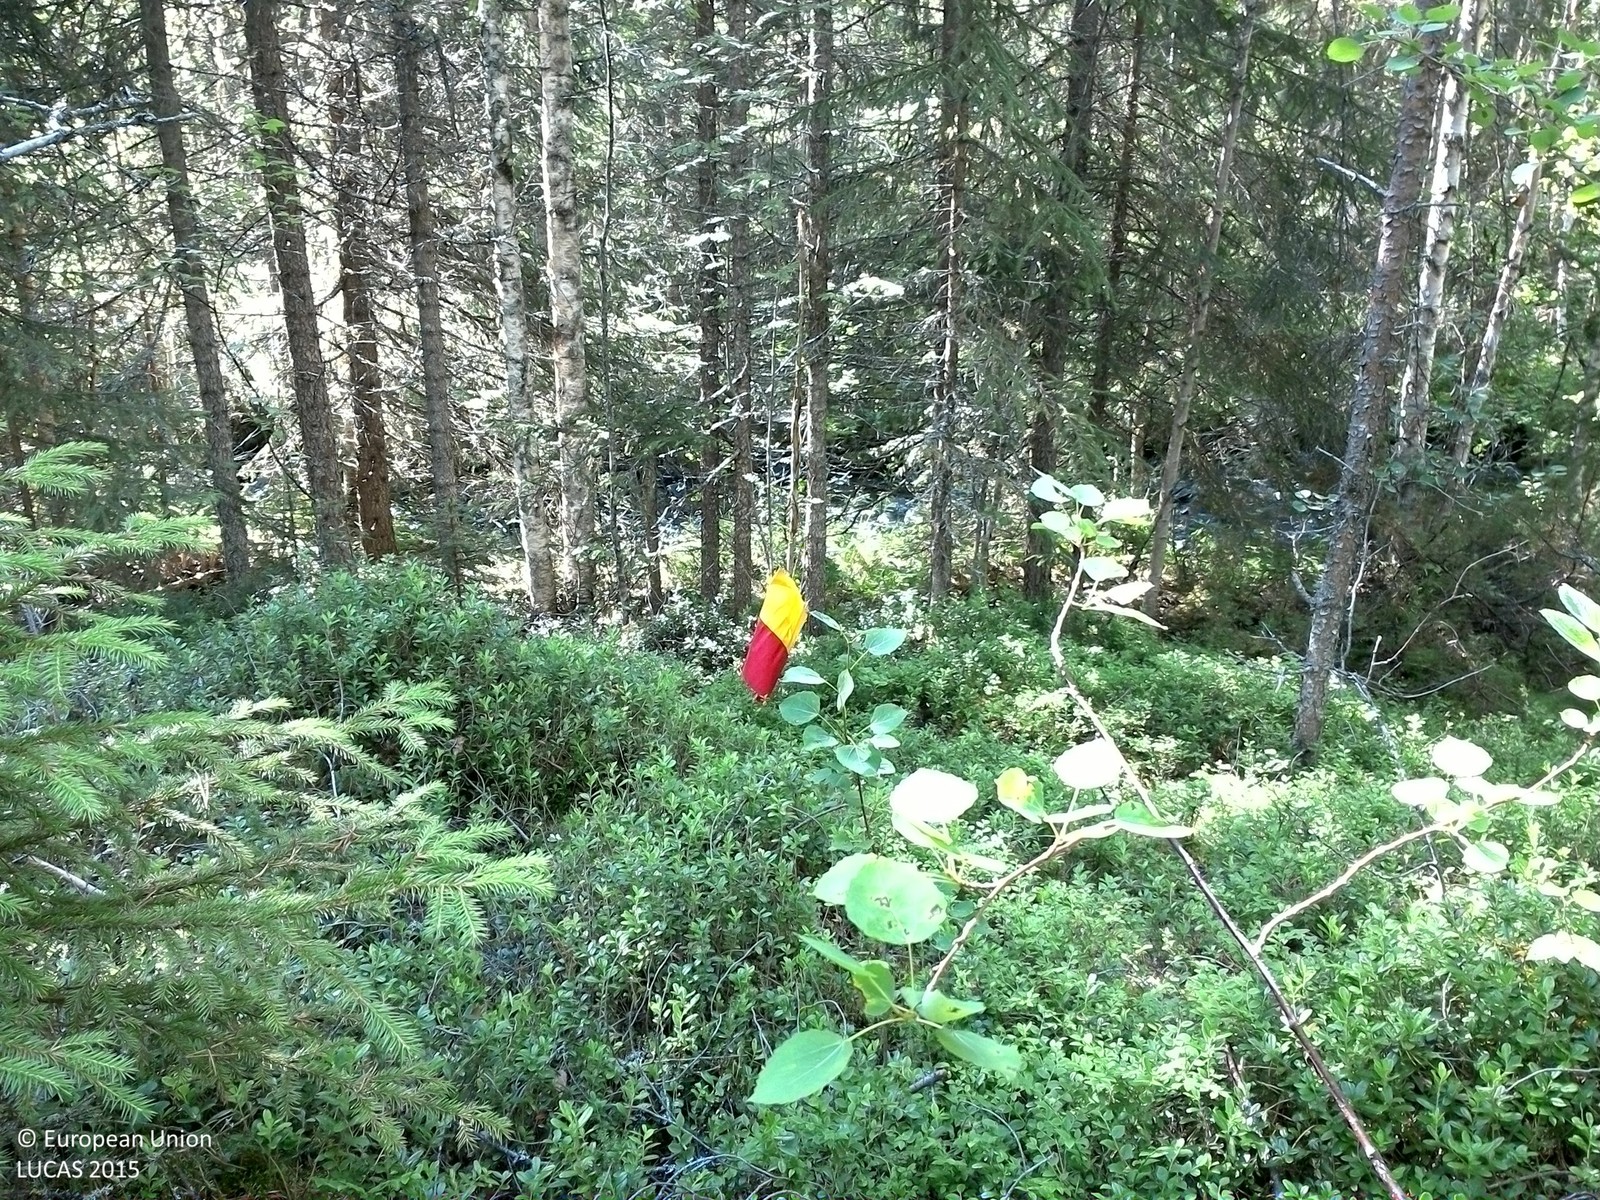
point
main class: Woodland
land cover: Pine dominated mixed woodland
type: boreal forest
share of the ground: 50 - 75 %
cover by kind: coniferous forest trees 45 %, shrubs 25 %, broadleaved forest trees 15 %, lichens and mosses 10 %, herbaceous plants 5 %
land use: Forestry
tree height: > 5 m
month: August
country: SE
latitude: 63.7259
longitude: 16.3911
